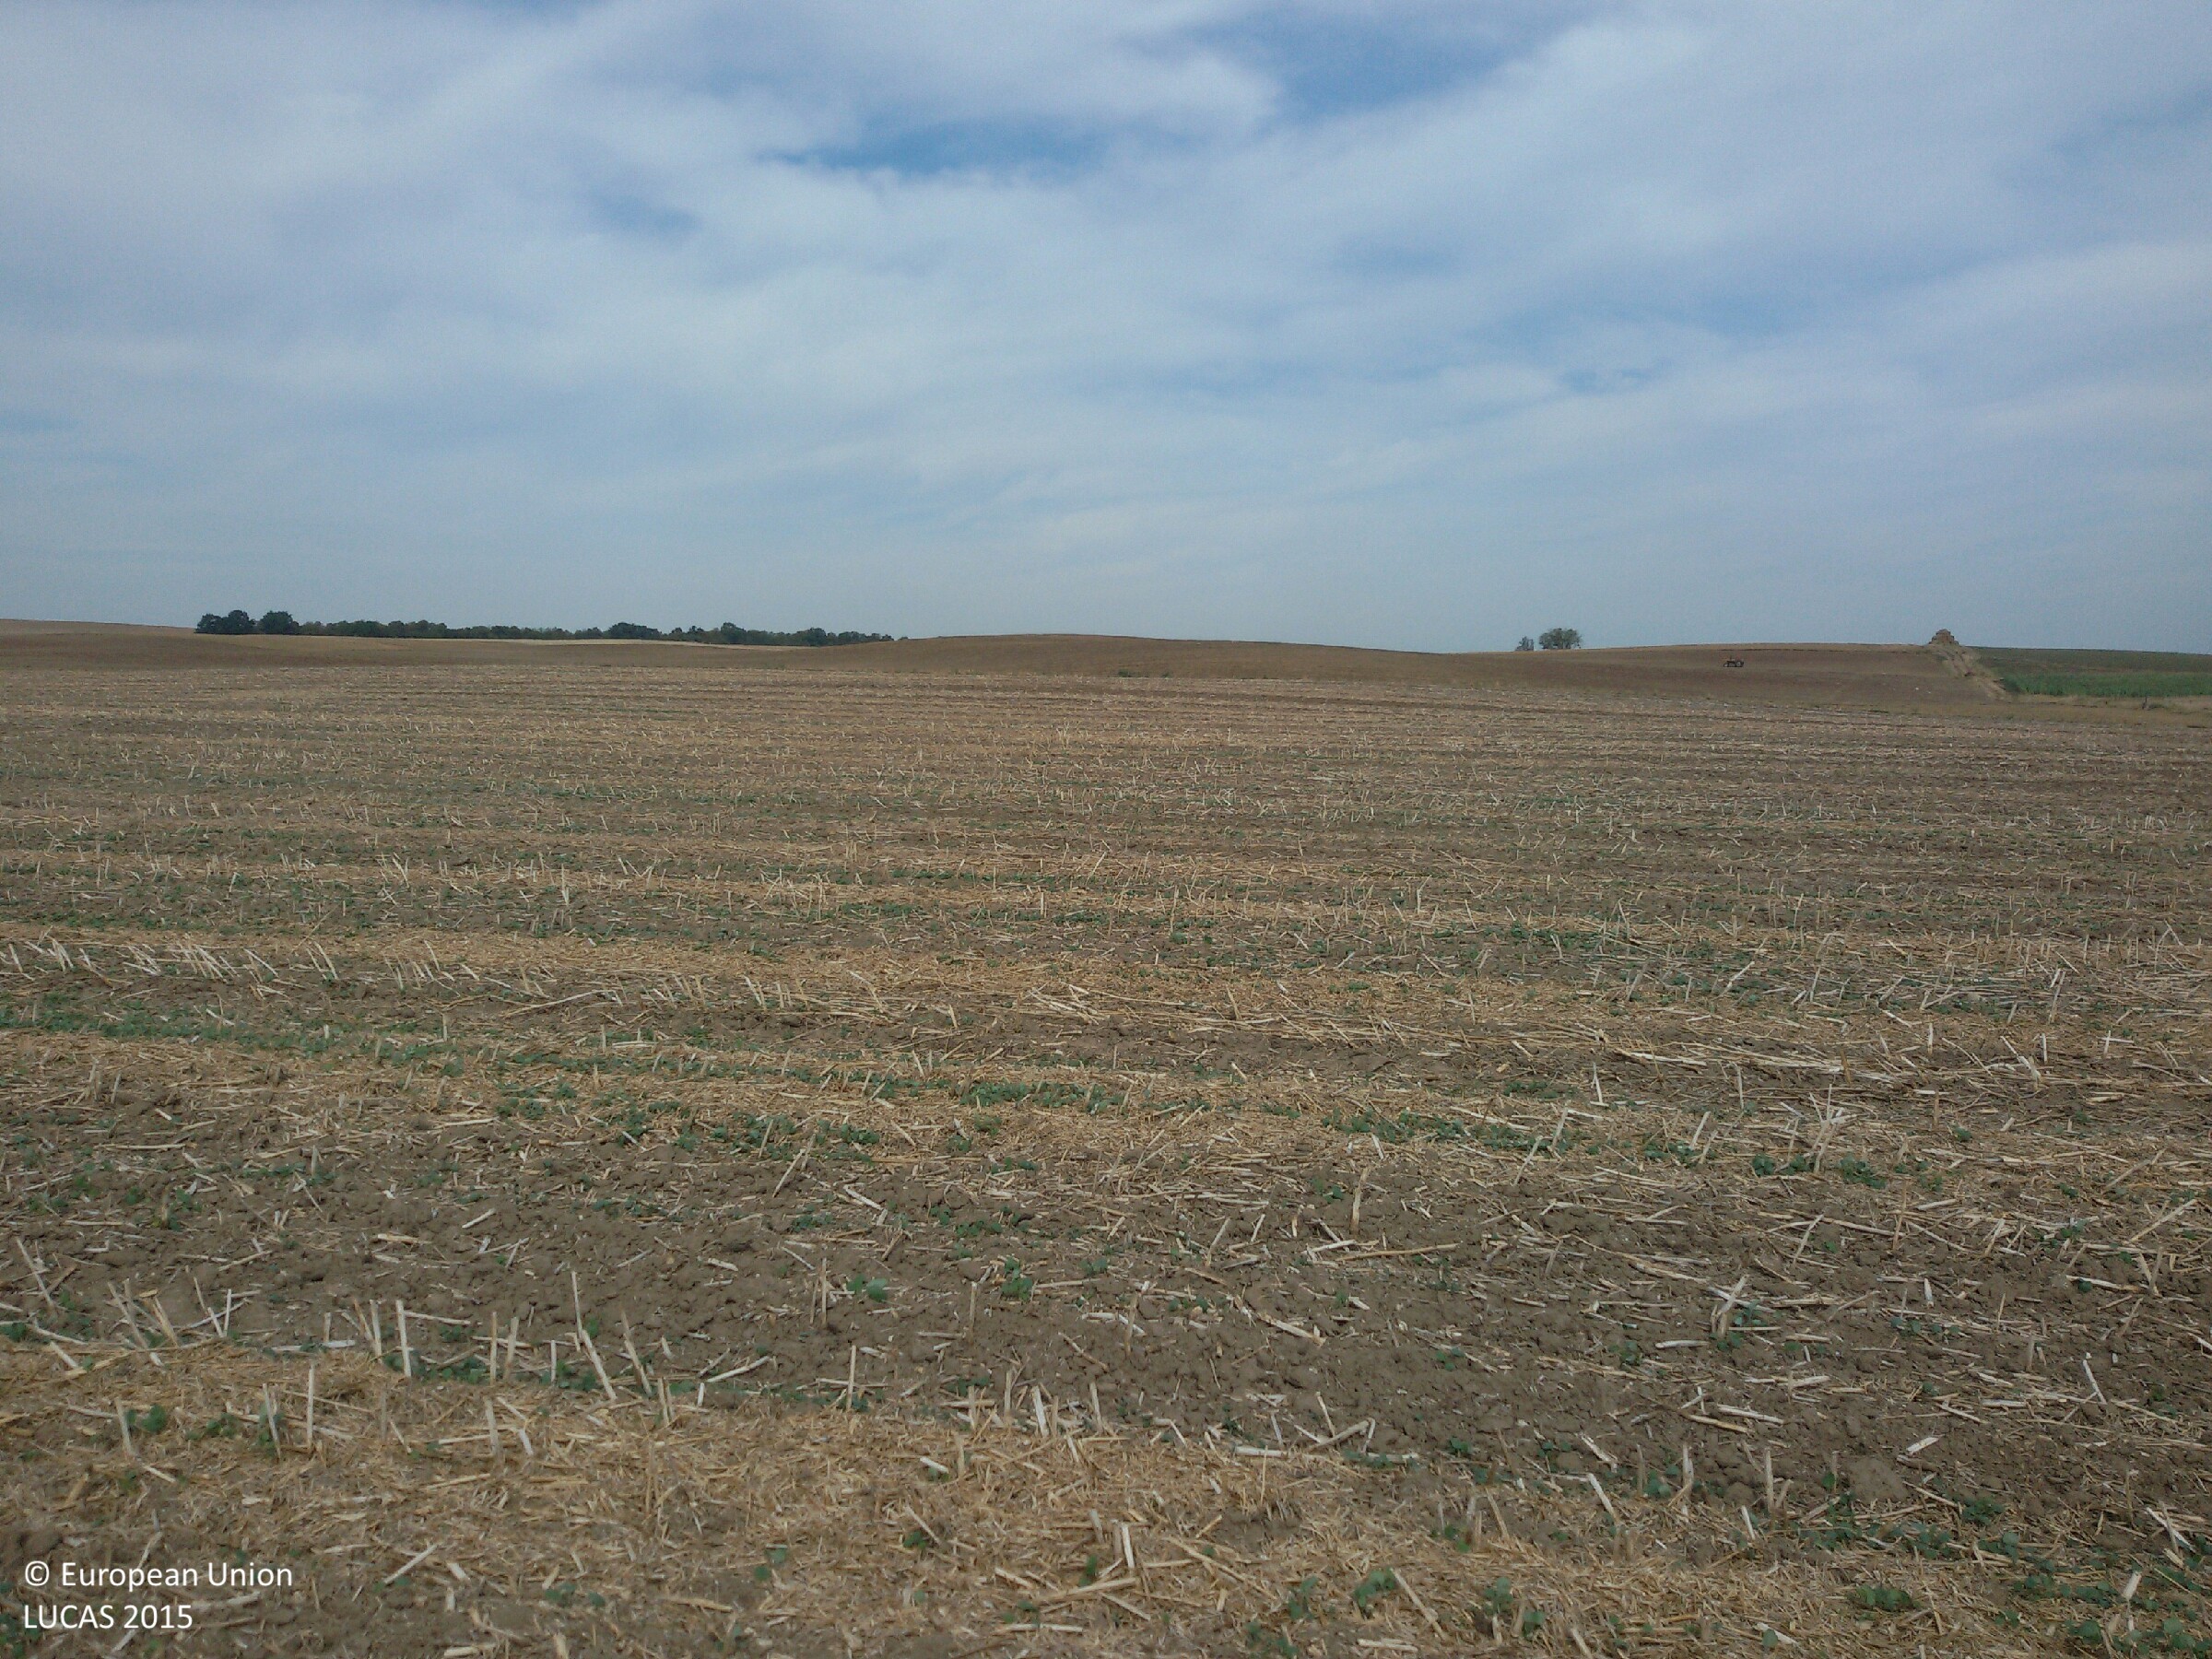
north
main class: Cropland
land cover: Rape and turnip rape
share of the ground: 25 - 50 %
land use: Agriculture (excluding fallow land and kitchen gardens)
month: August
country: PL
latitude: 53.9815
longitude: 19.3417
